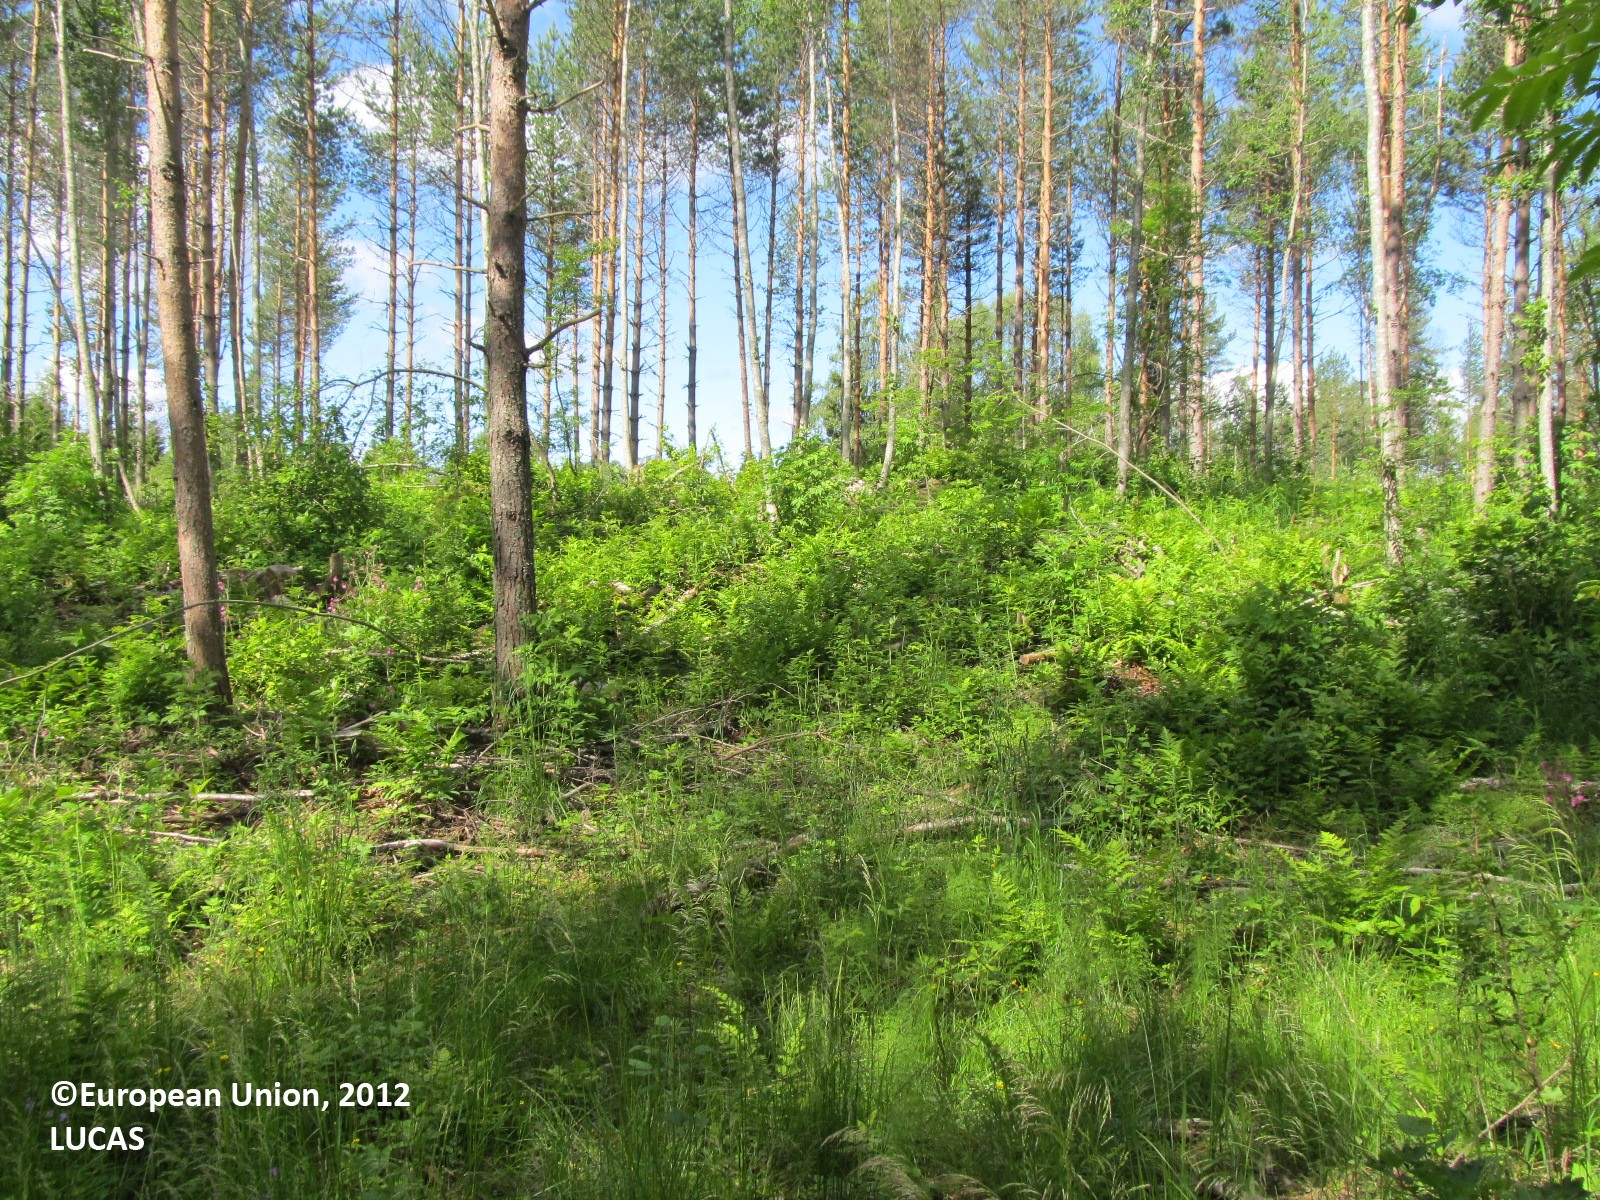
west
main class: Woodland
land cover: Pine dominated coniferous woodland
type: boreal forest
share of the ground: 25 - 50 %
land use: Forestry
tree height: > 5 m
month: June
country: FI
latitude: 62.7099
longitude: 28.8425
